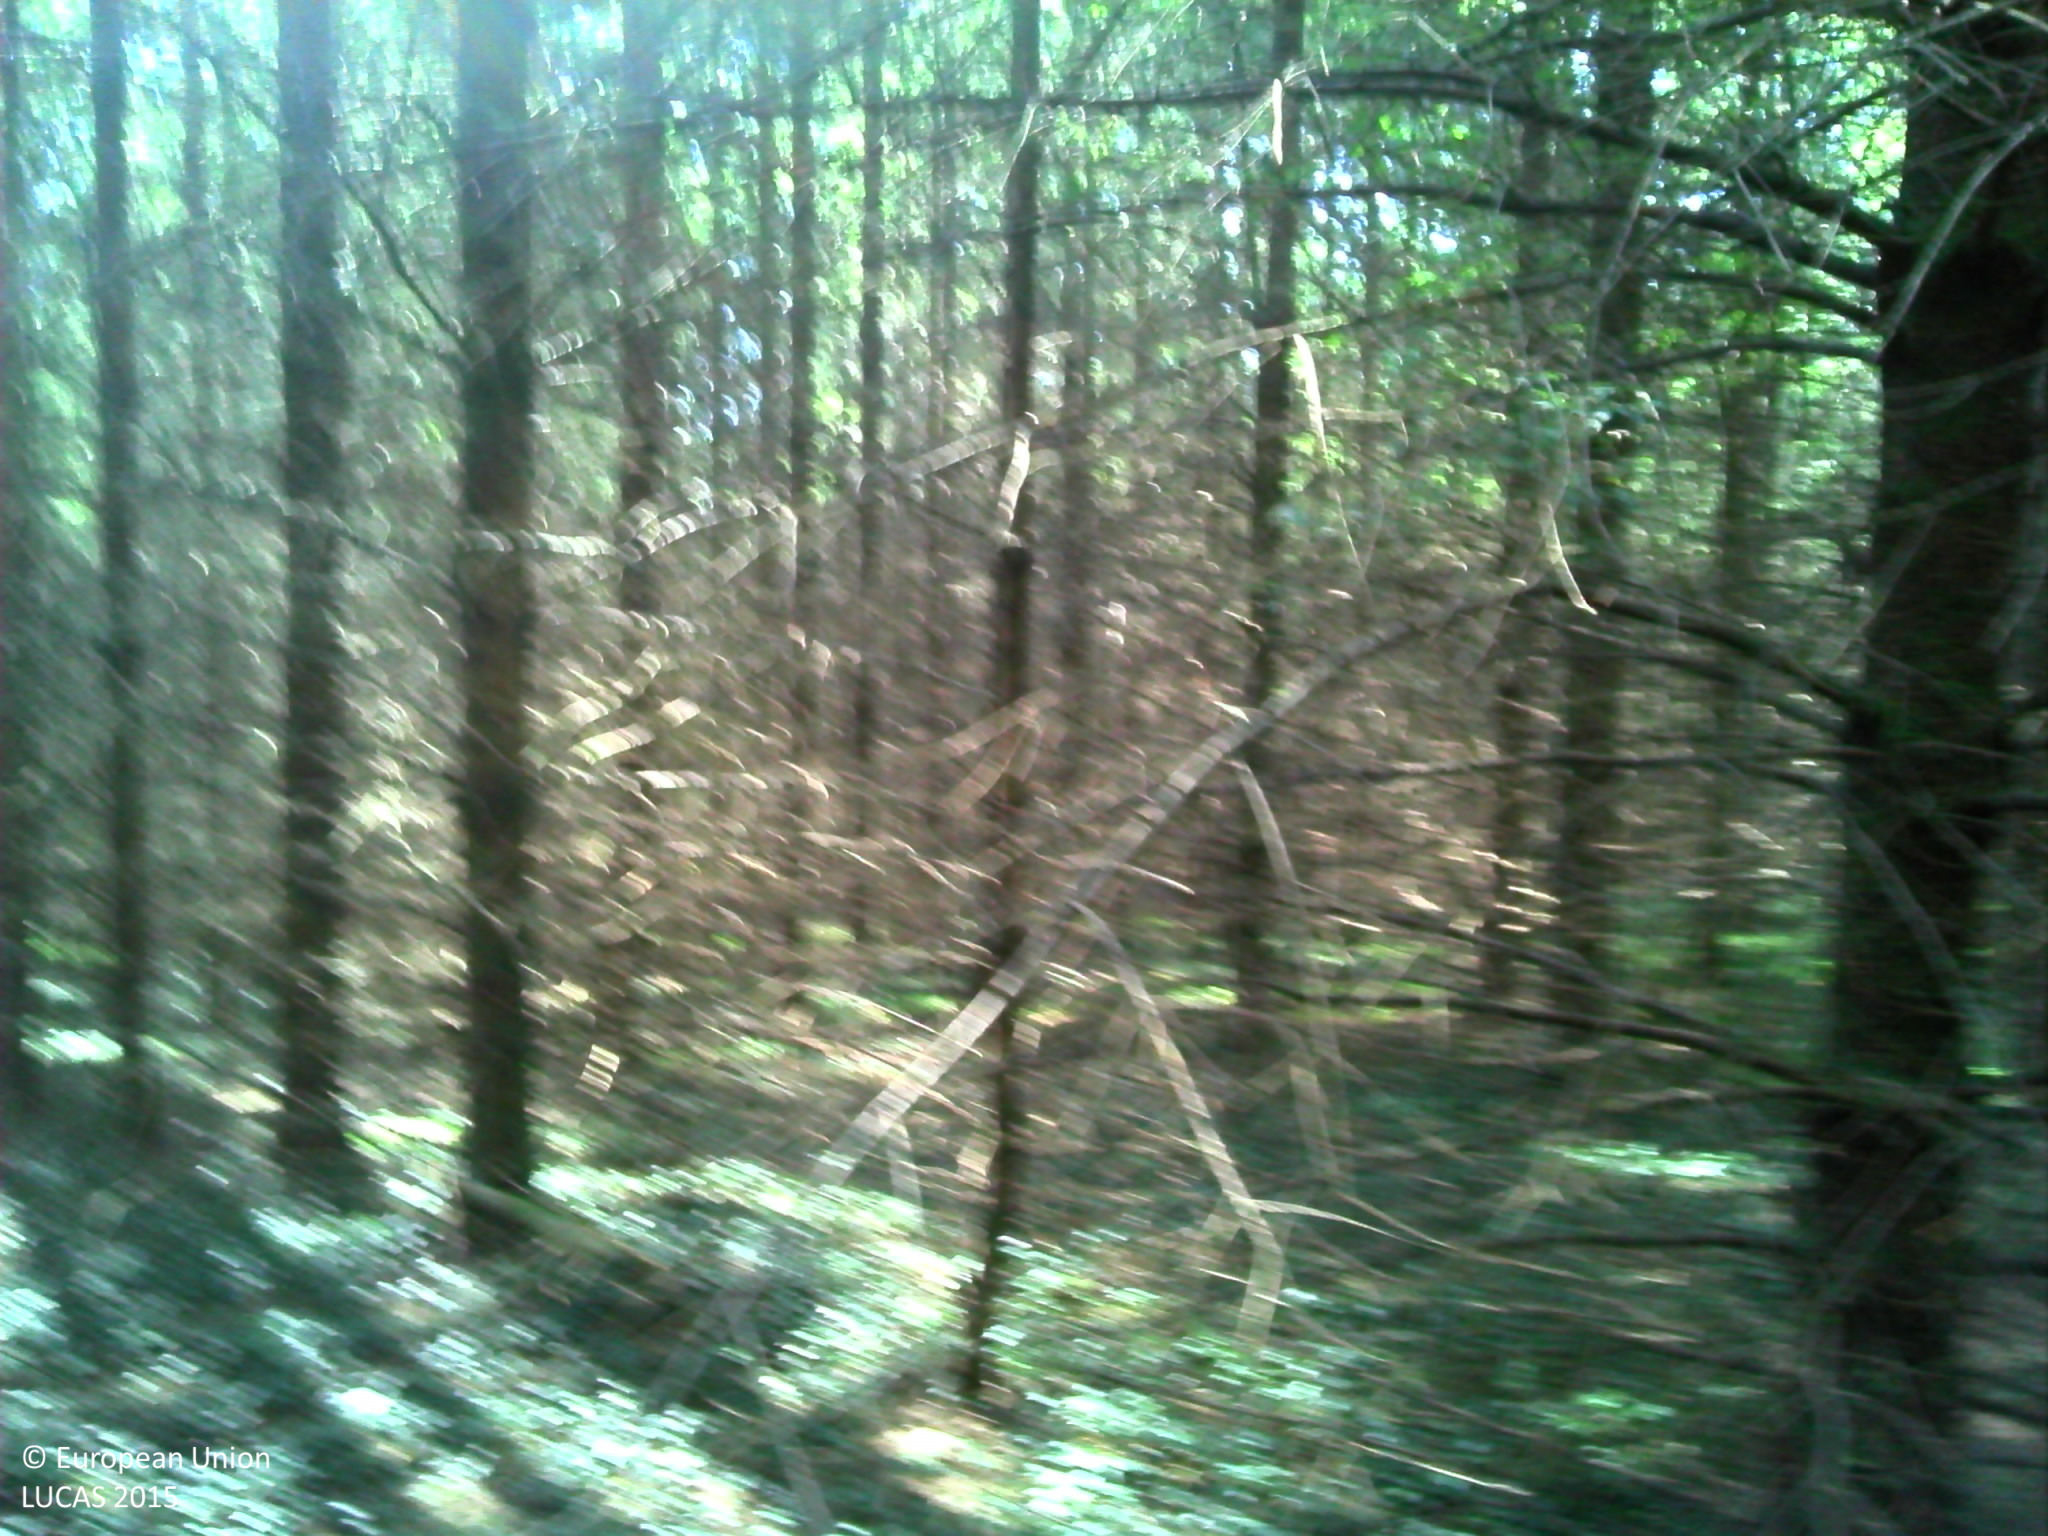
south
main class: Woodland
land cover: Spruce dominated coniferous woodland
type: hemiboreal forest and nemoral coniferous forest and mixed broadleaved-coniferous forest
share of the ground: > 75 %
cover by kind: coniferous forest trees 75 %, herbaceous plants 25 %
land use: Forestry
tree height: > 5 m
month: September
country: FR
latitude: 47.2054
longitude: 6.2658
